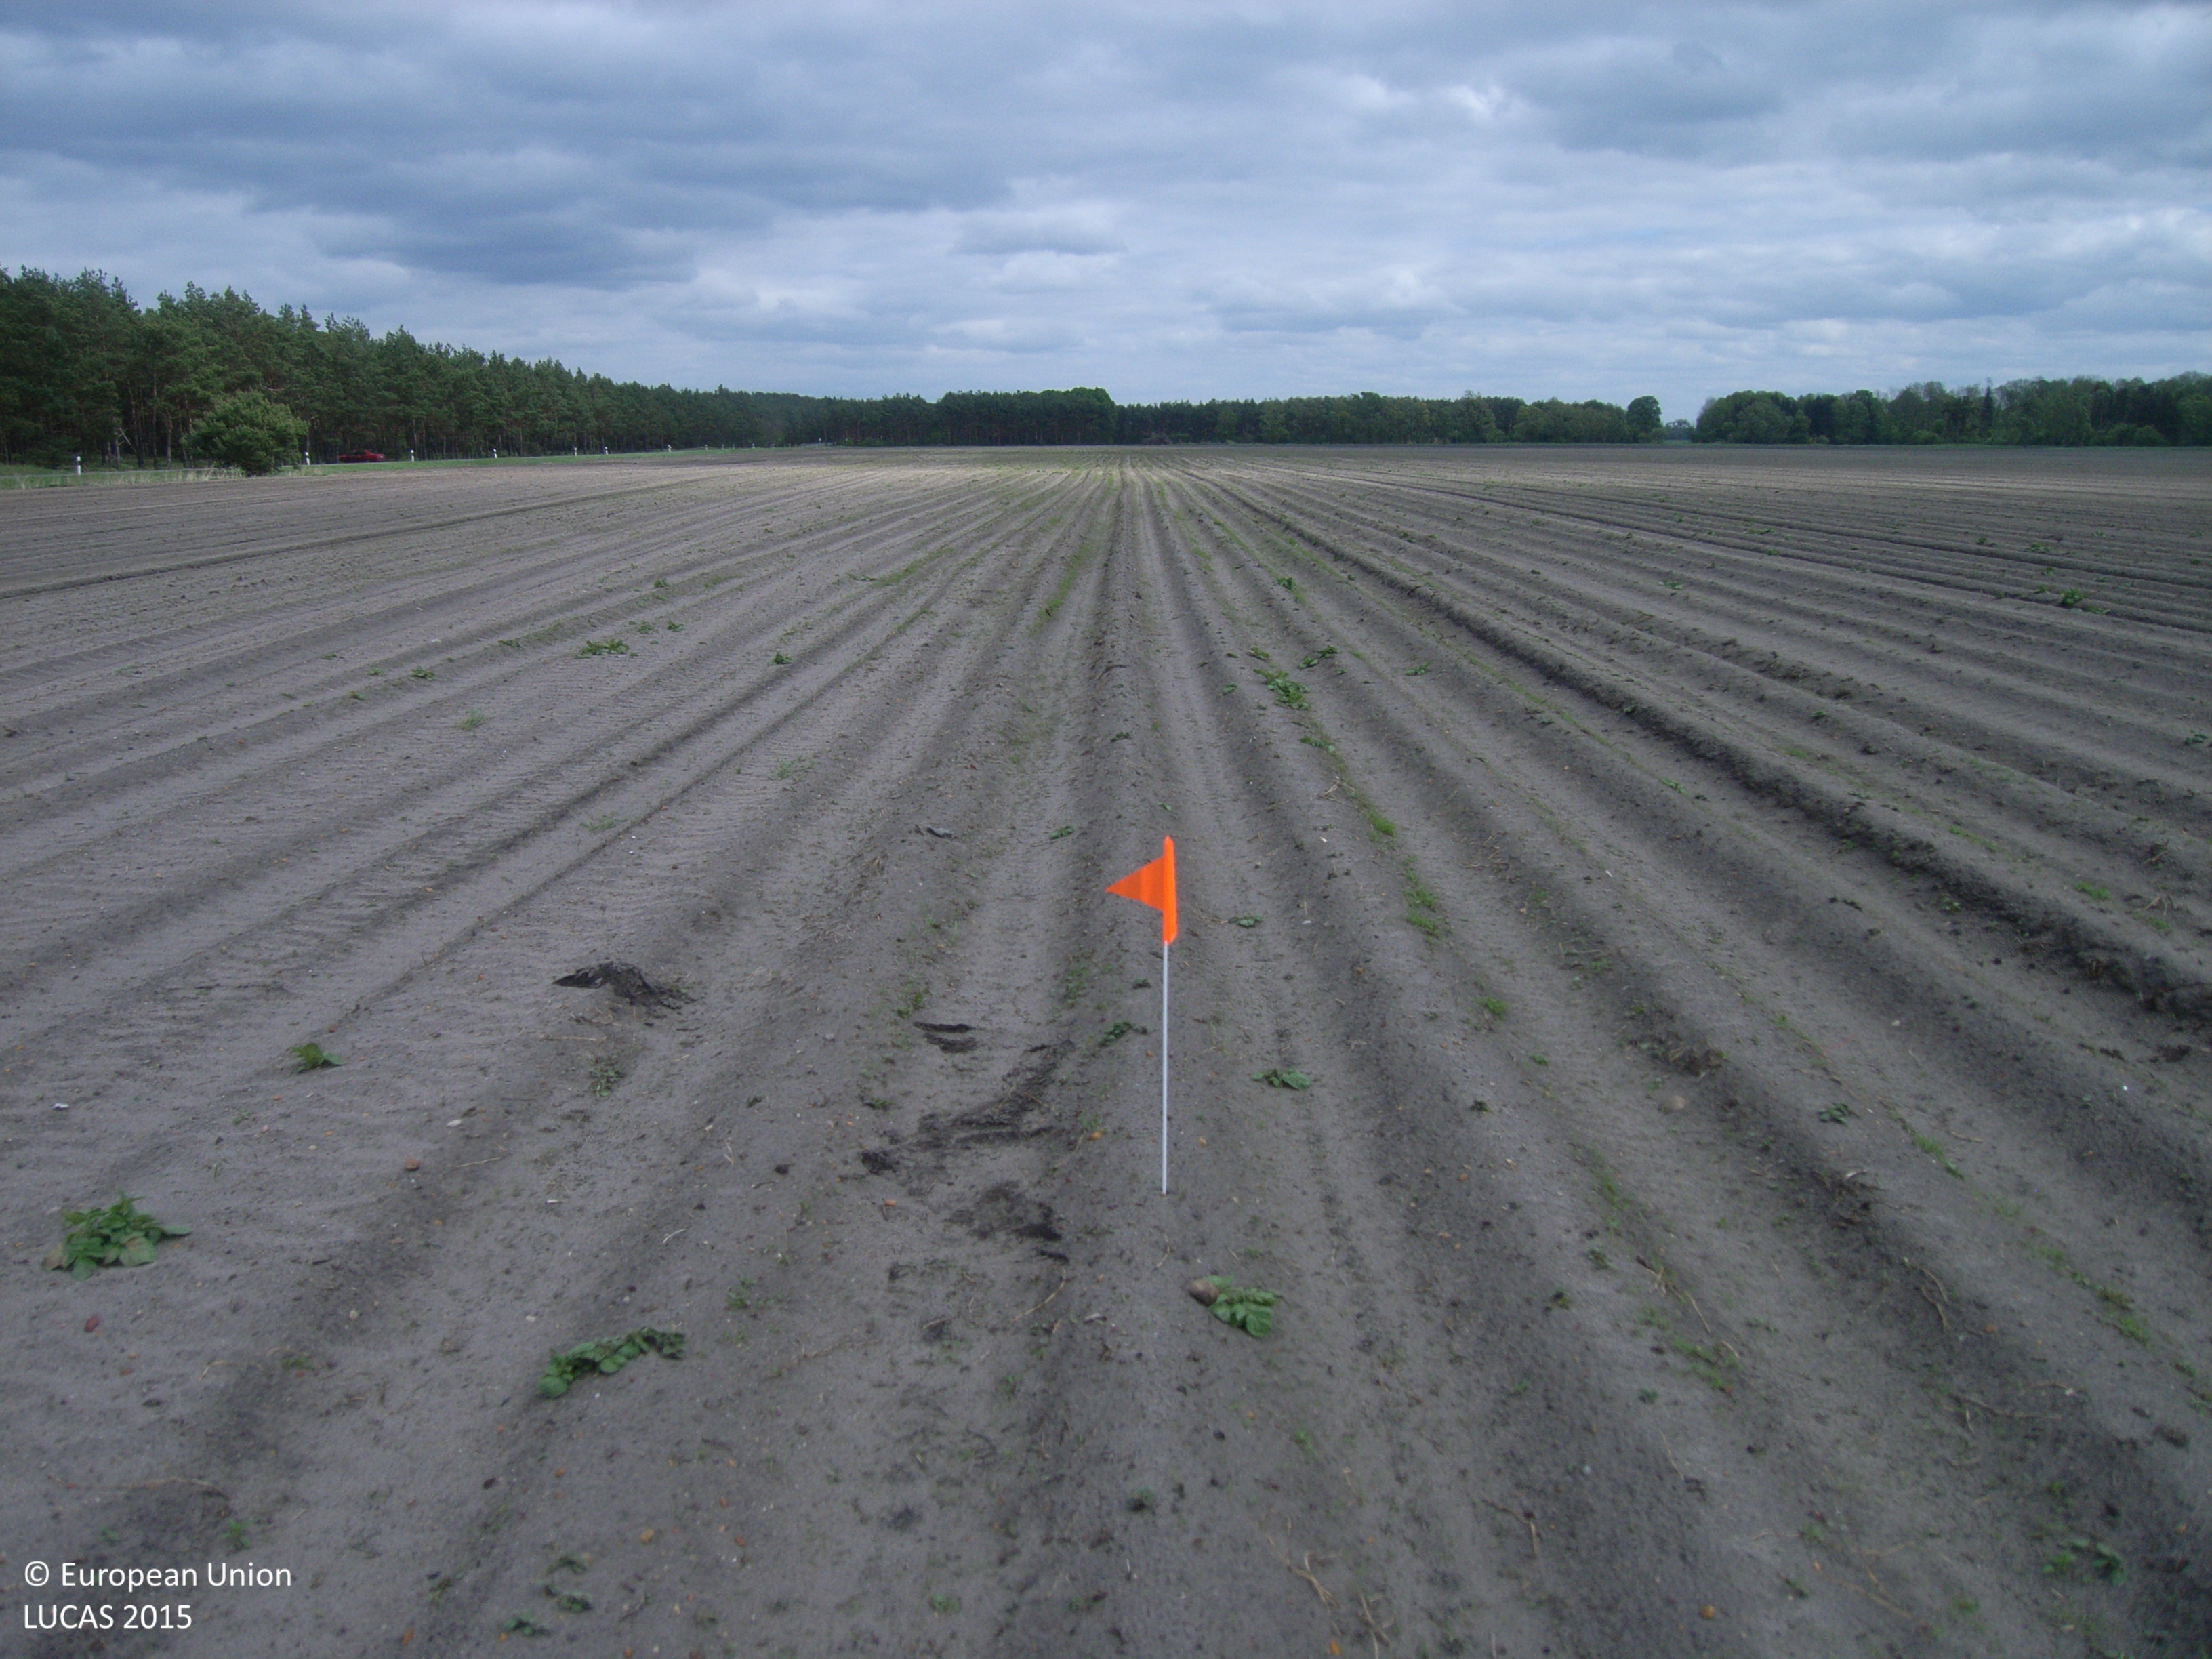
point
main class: Cropland
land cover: Potatoes
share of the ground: < 10 %
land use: Agriculture (excluding fallow land and kitchen gardens)
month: May
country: DE
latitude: 52.0538
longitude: 13.5733
